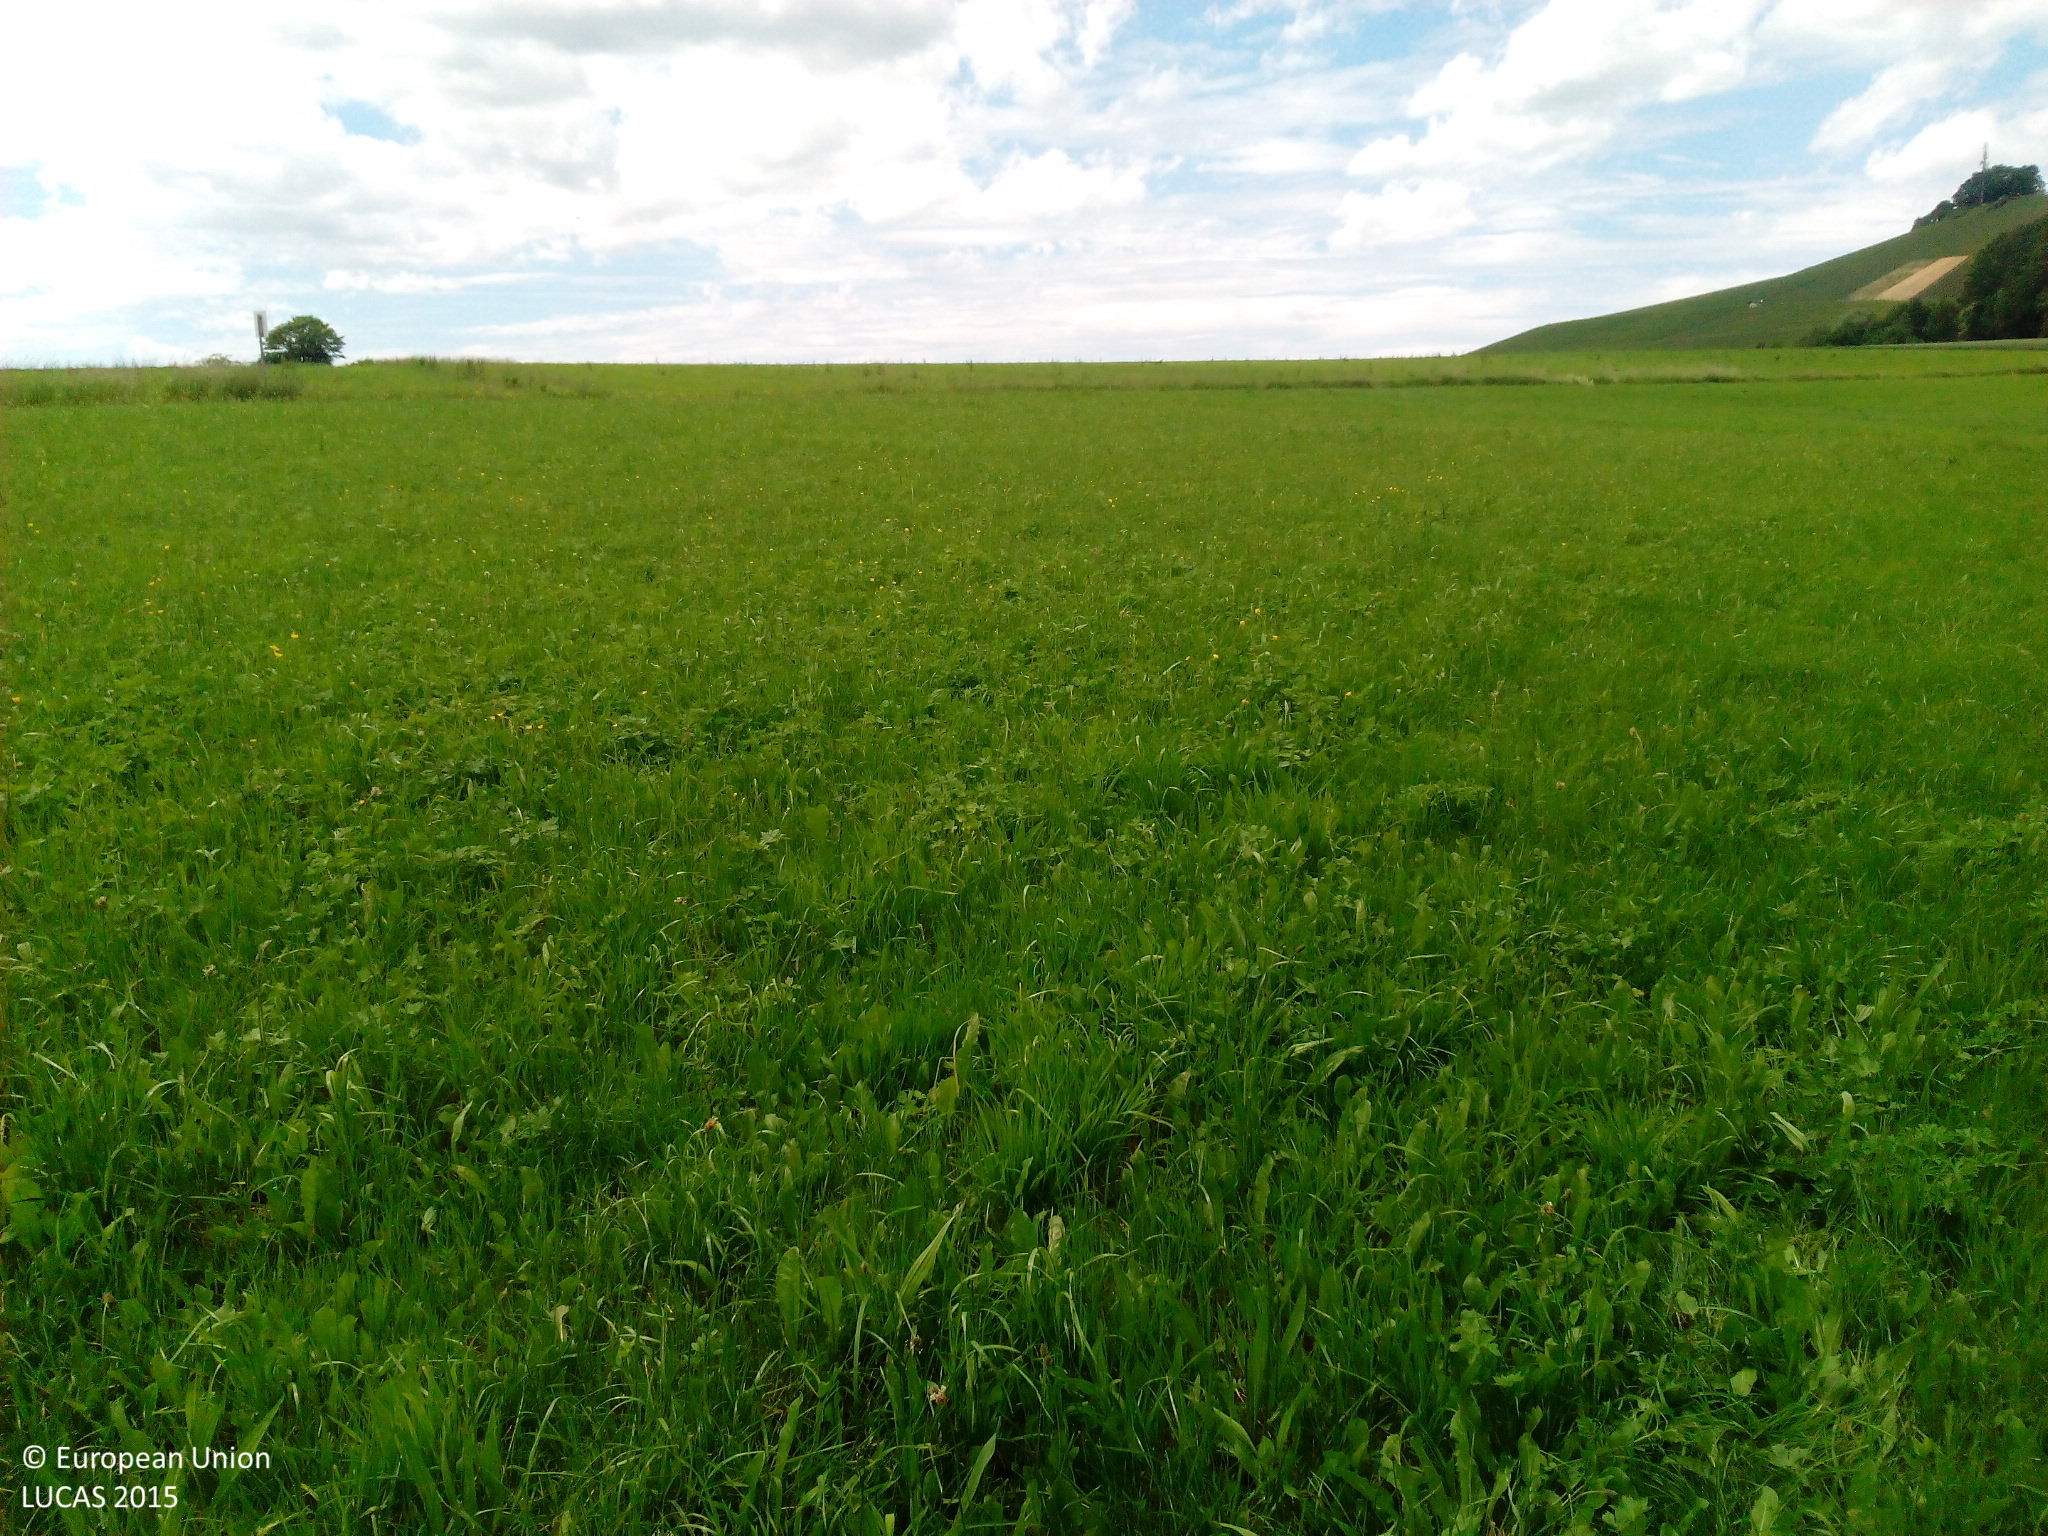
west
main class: Grassland
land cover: Grassland without tree/shrub cover
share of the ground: > 75 %
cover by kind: herbaceous plants 100 %
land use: Agriculture (excluding fallow land and kitchen gardens)
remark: Harvested field
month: June
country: DE
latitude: 48.9955
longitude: 9.3852
